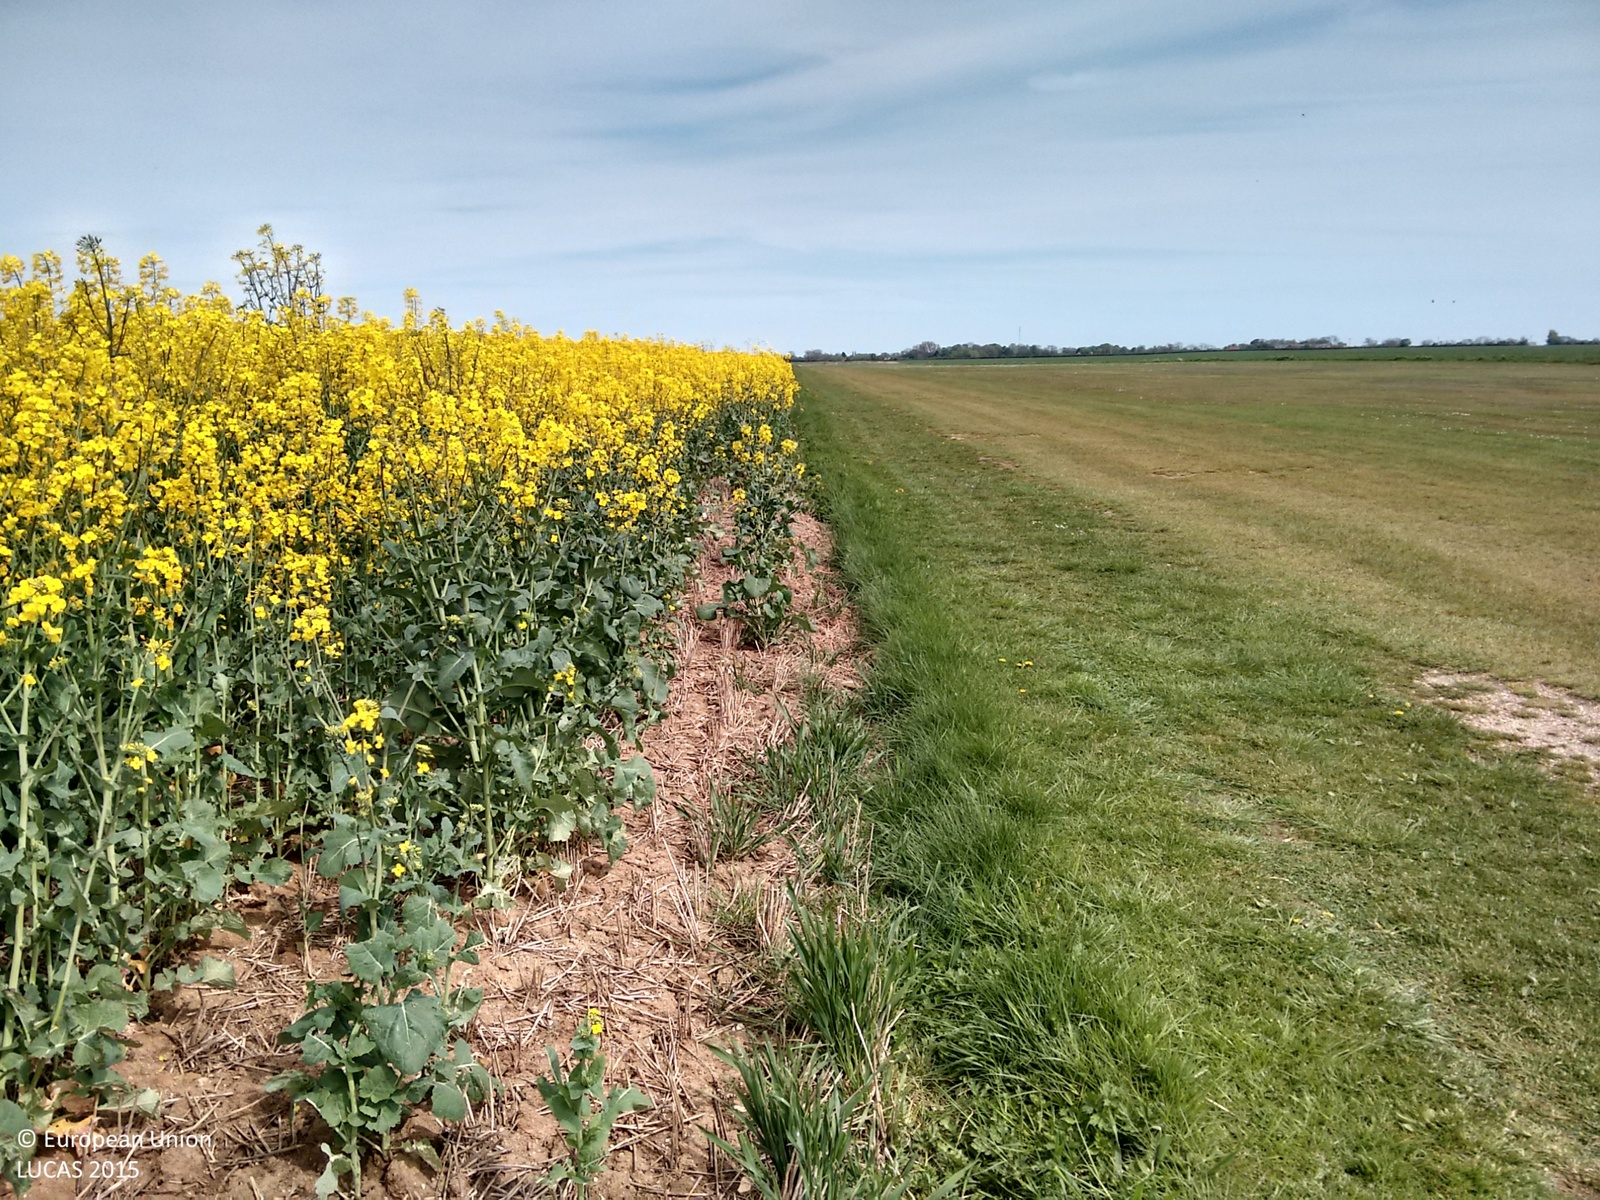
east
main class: Cropland
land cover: Rape and turnip rape
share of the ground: > 75 %
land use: Agriculture (excluding fallow land and kitchen gardens)
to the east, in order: Rape and turnip rape; Grass margins; Common wheat
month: May
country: GB
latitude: 53.3090
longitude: 0.1696
